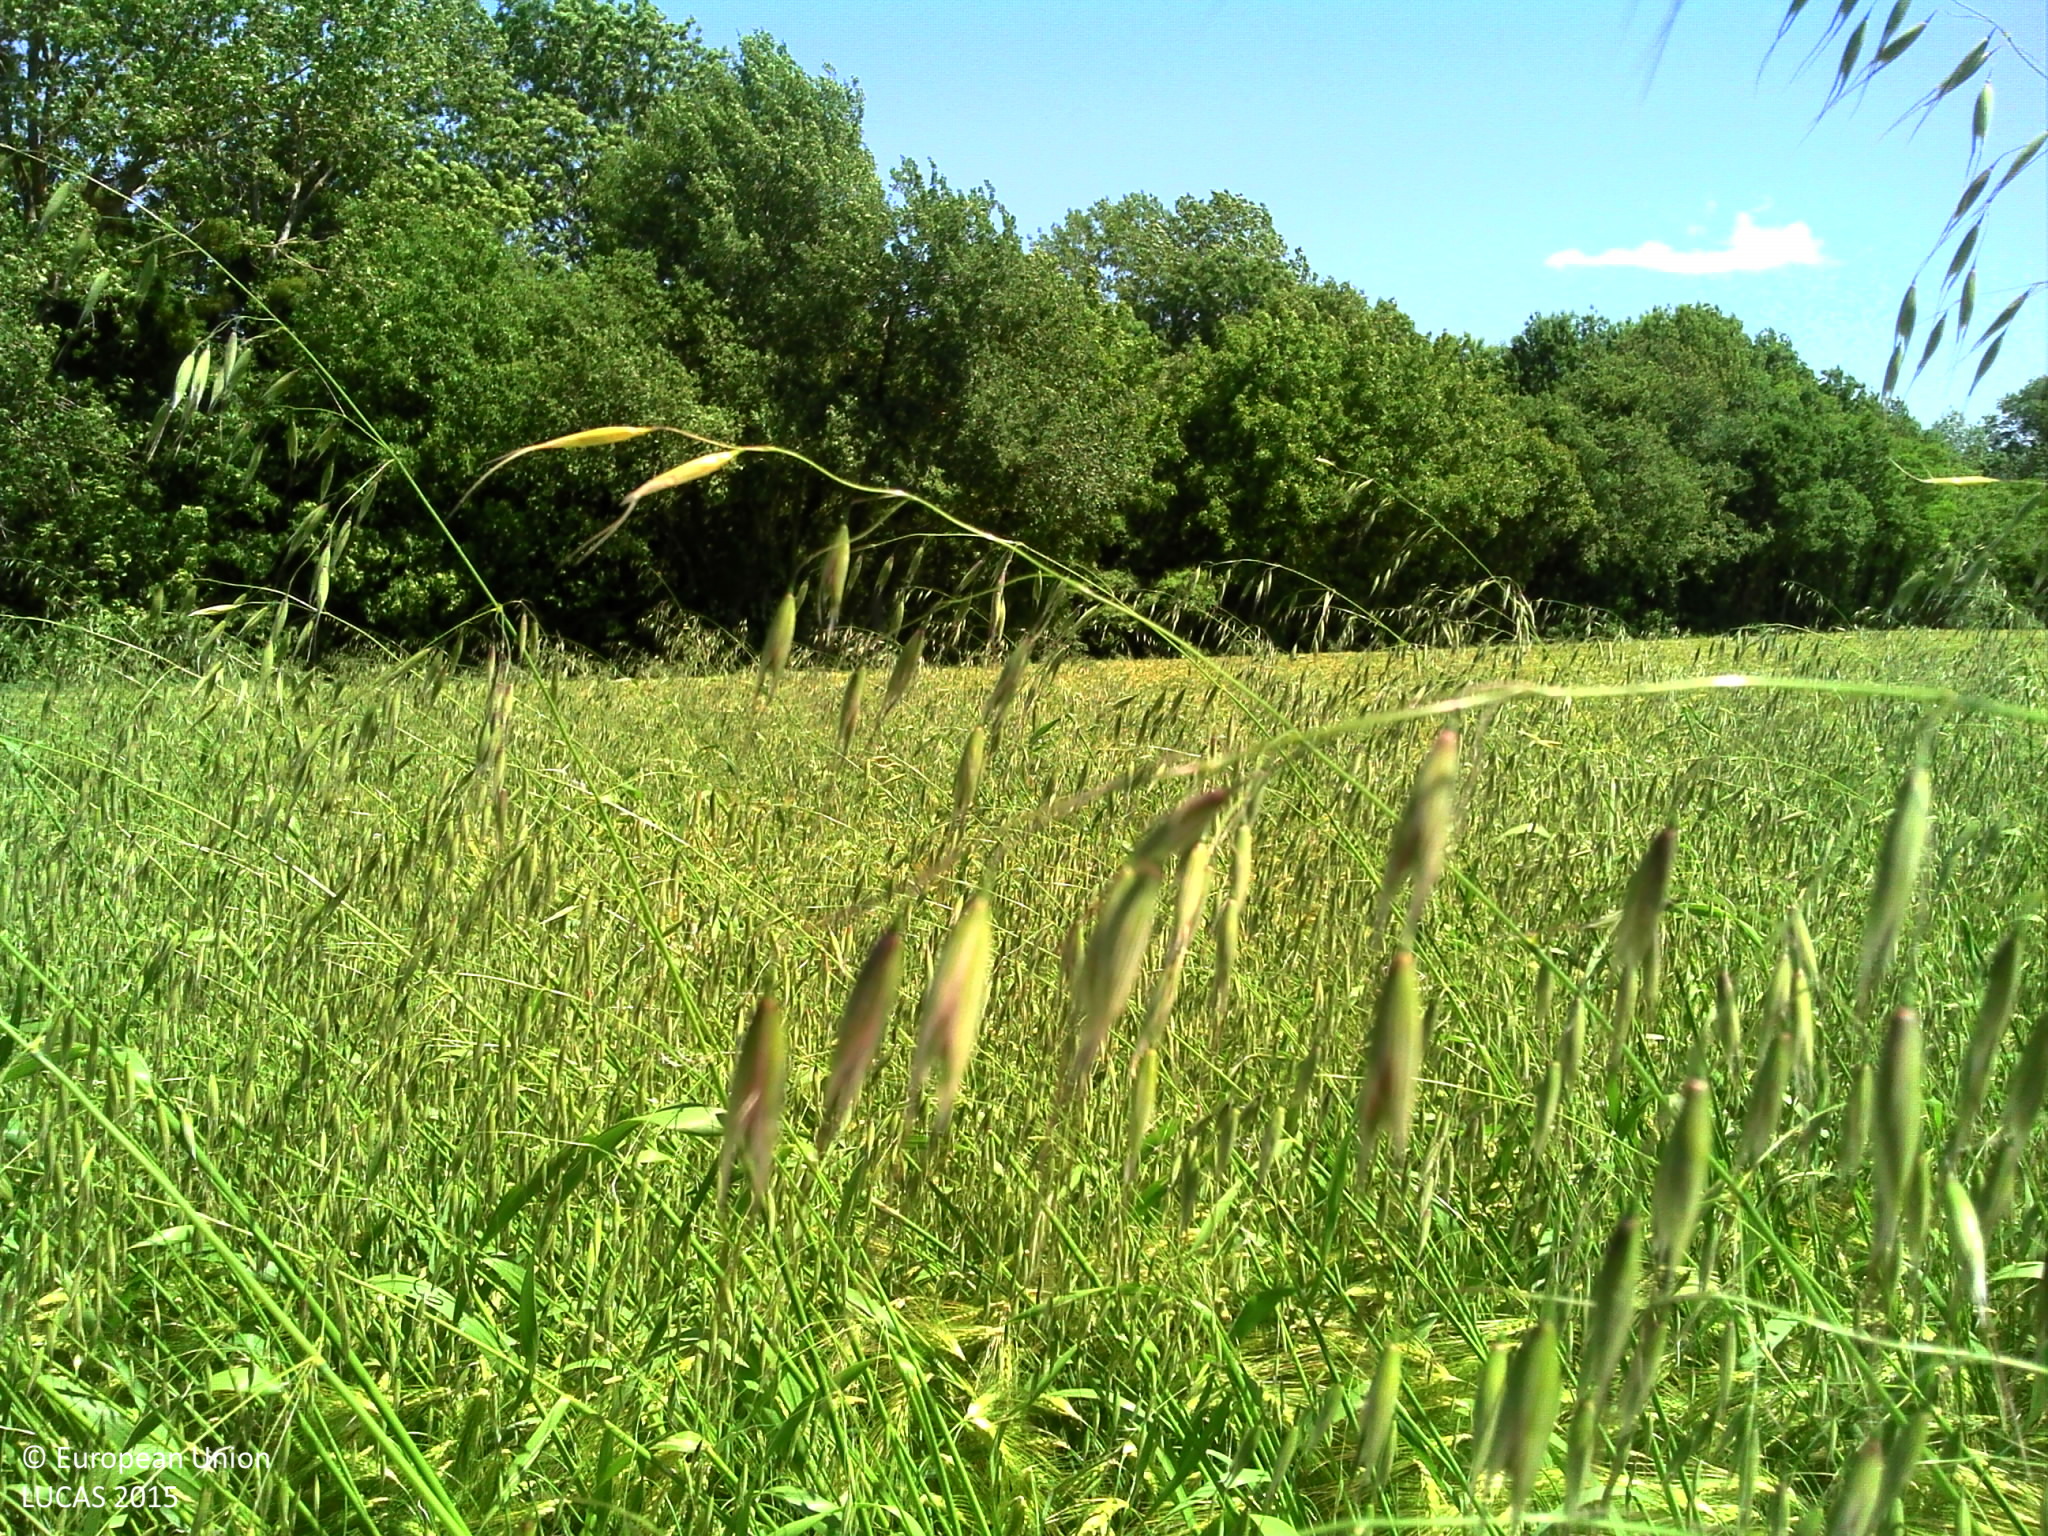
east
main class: Cropland
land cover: Mixed cereals for fodder
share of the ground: > 75 %
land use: Agriculture (excluding fallow land and kitchen gardens)
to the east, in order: Mixed cereals for fodder; Shruby margins; Broadleaved woodland; Ditches and canals; Grassland without tree/shrub cover; Common wheat
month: June
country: FR
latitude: 47.2287
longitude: 5.0479
